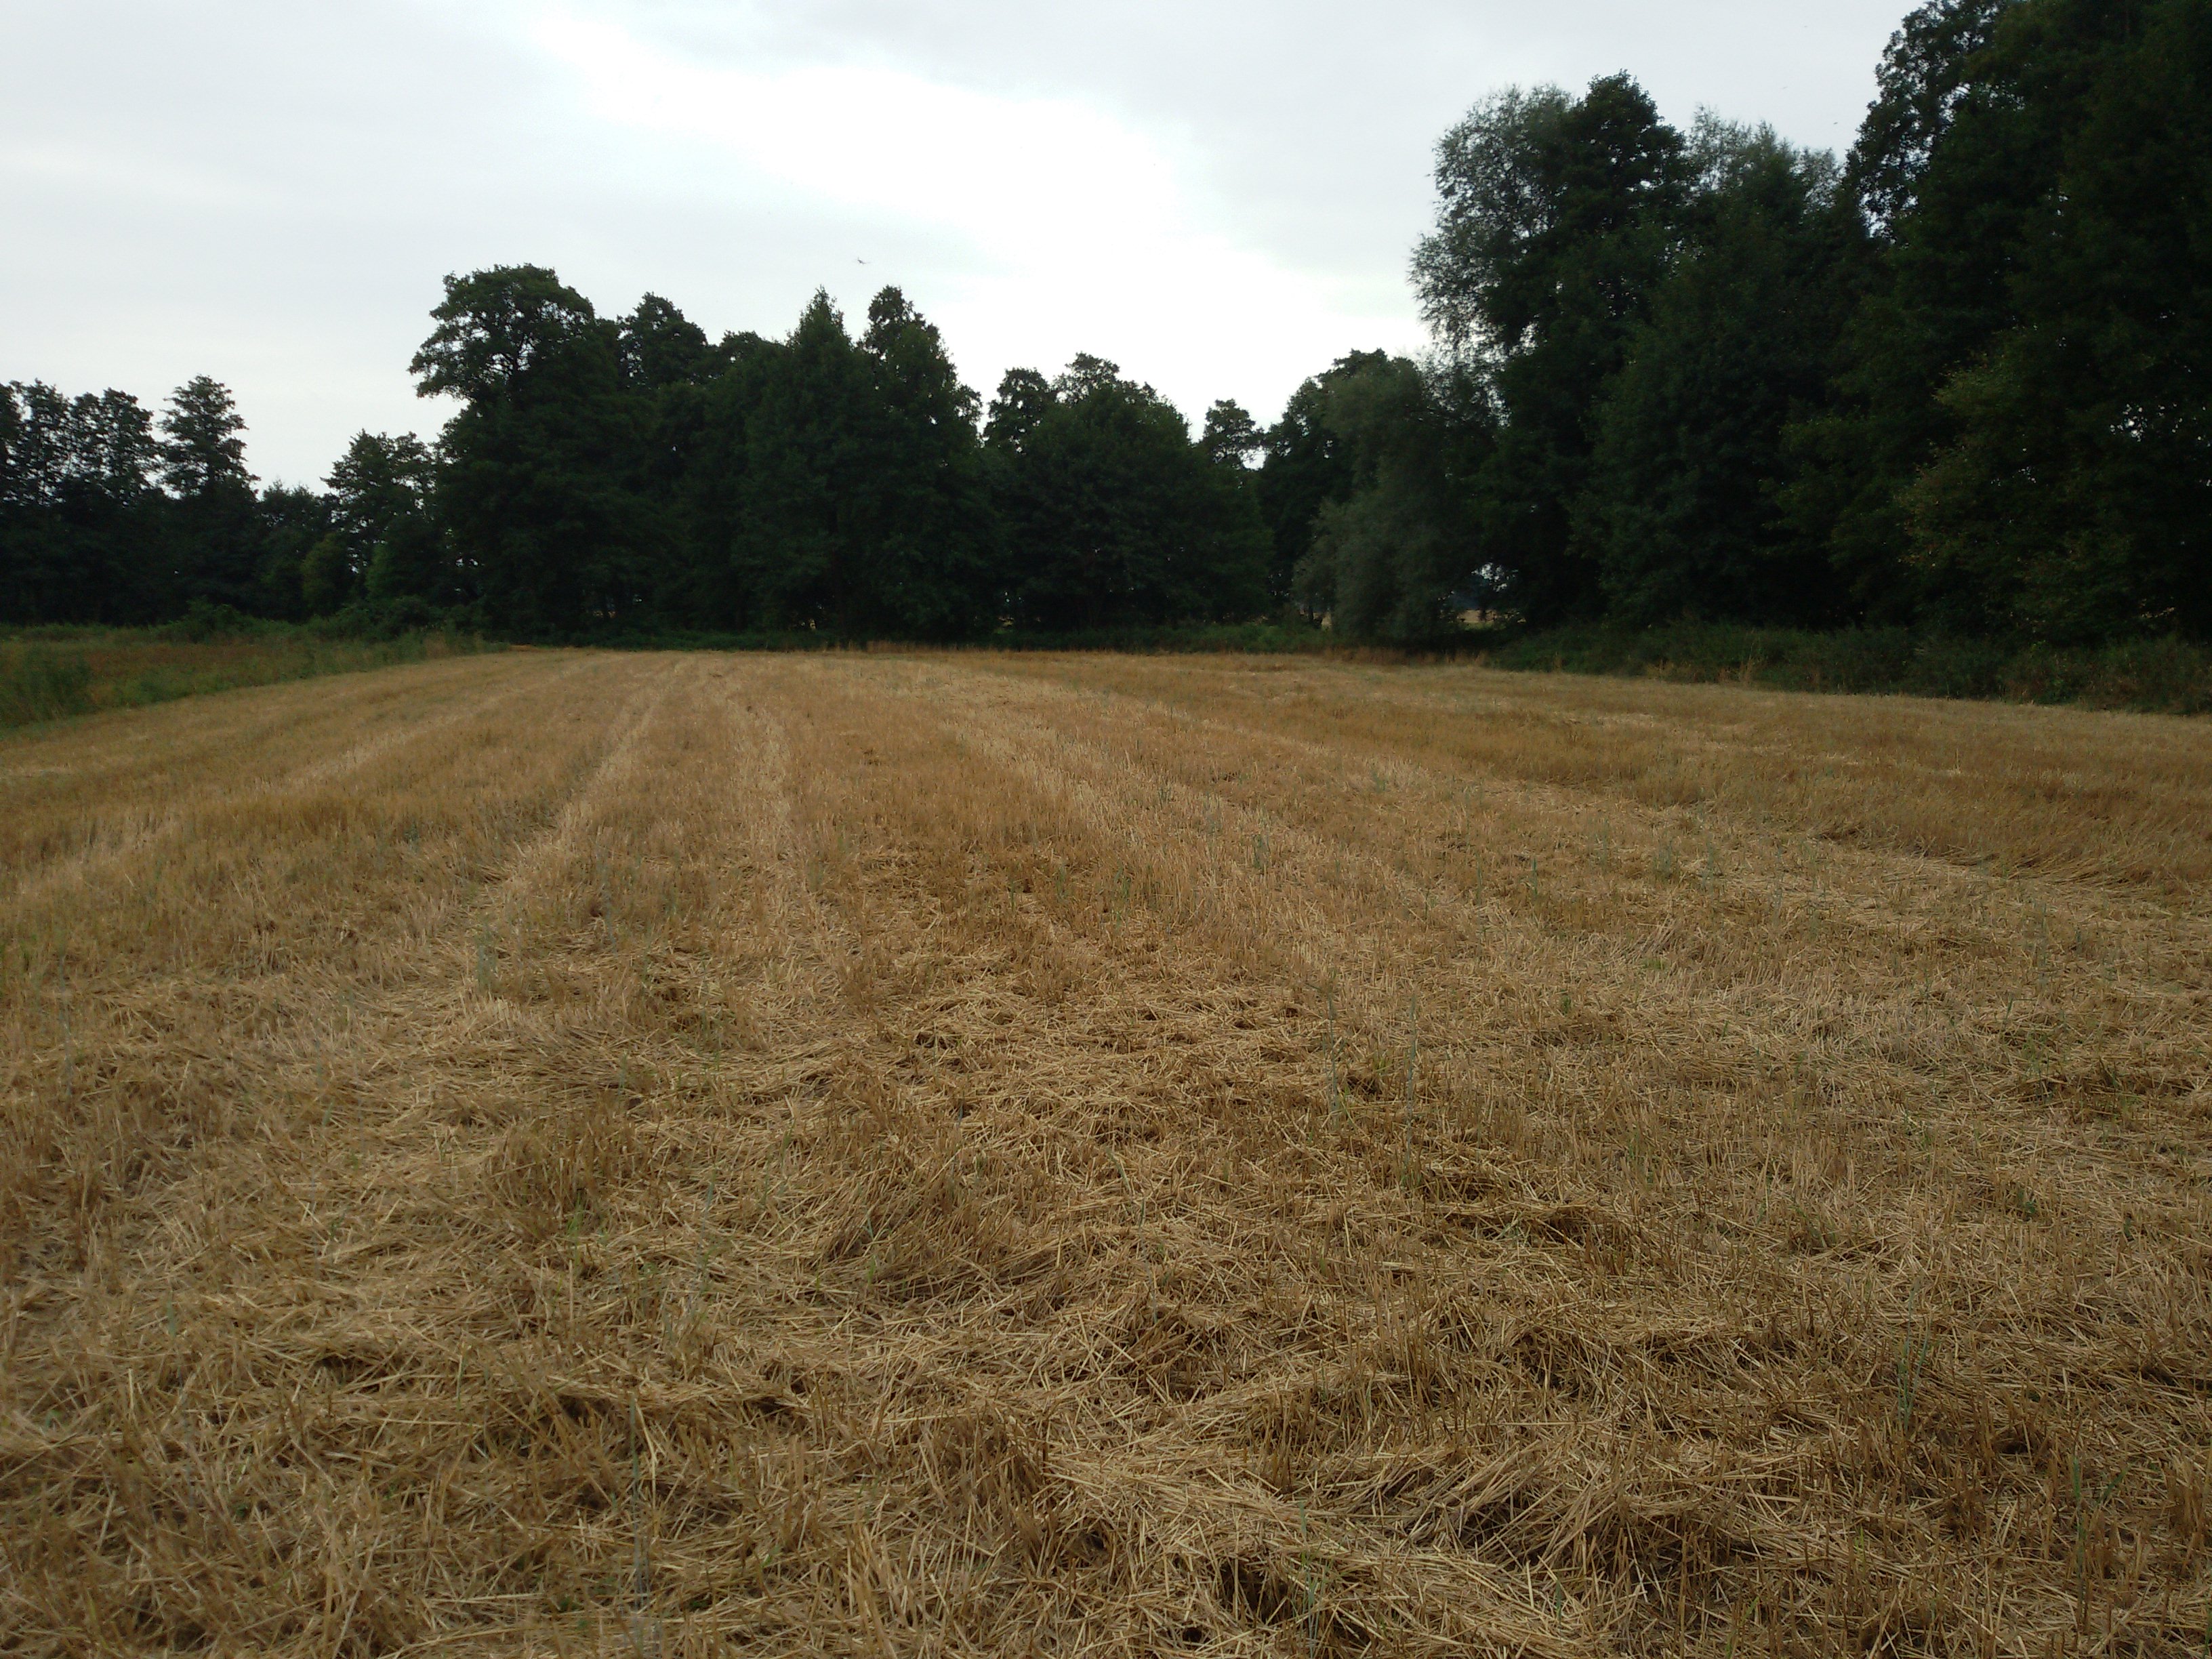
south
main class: Cropland
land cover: Common wheat
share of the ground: > 75 %
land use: Agriculture (excluding fallow land and kitchen gardens)
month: August
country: PL
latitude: 51.7183
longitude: 17.8749
